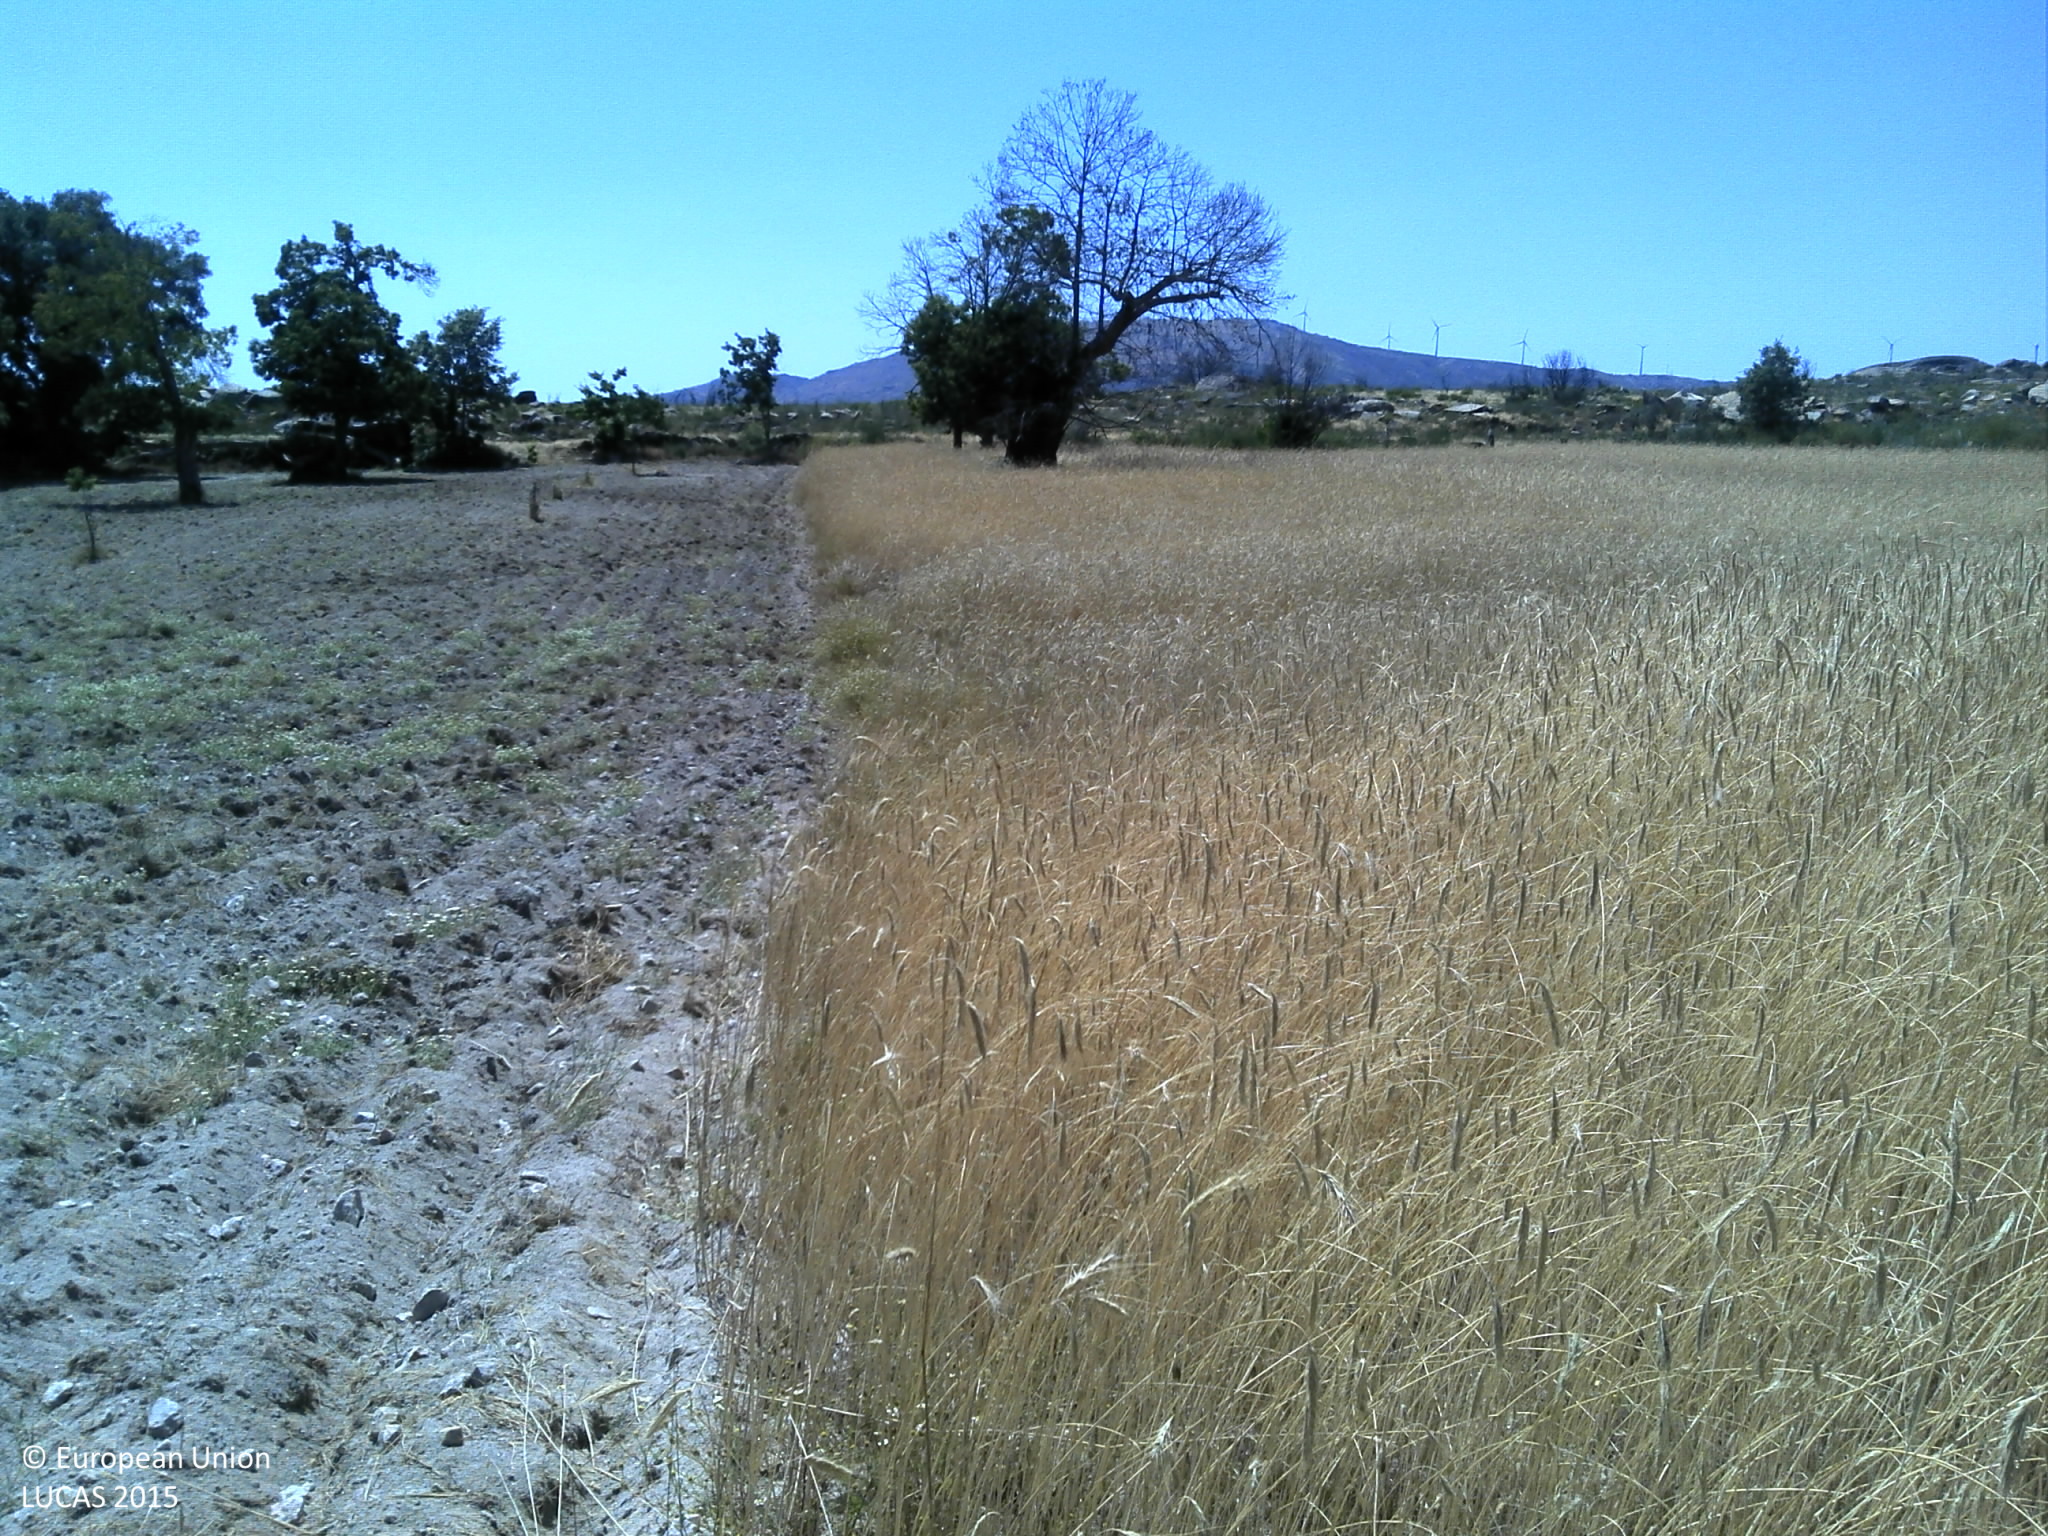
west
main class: Cropland
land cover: Rye
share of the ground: > 75 %
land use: Agriculture (excluding fallow land and kitchen gardens)
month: July
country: PT
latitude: 41.7296
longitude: -7.5768
